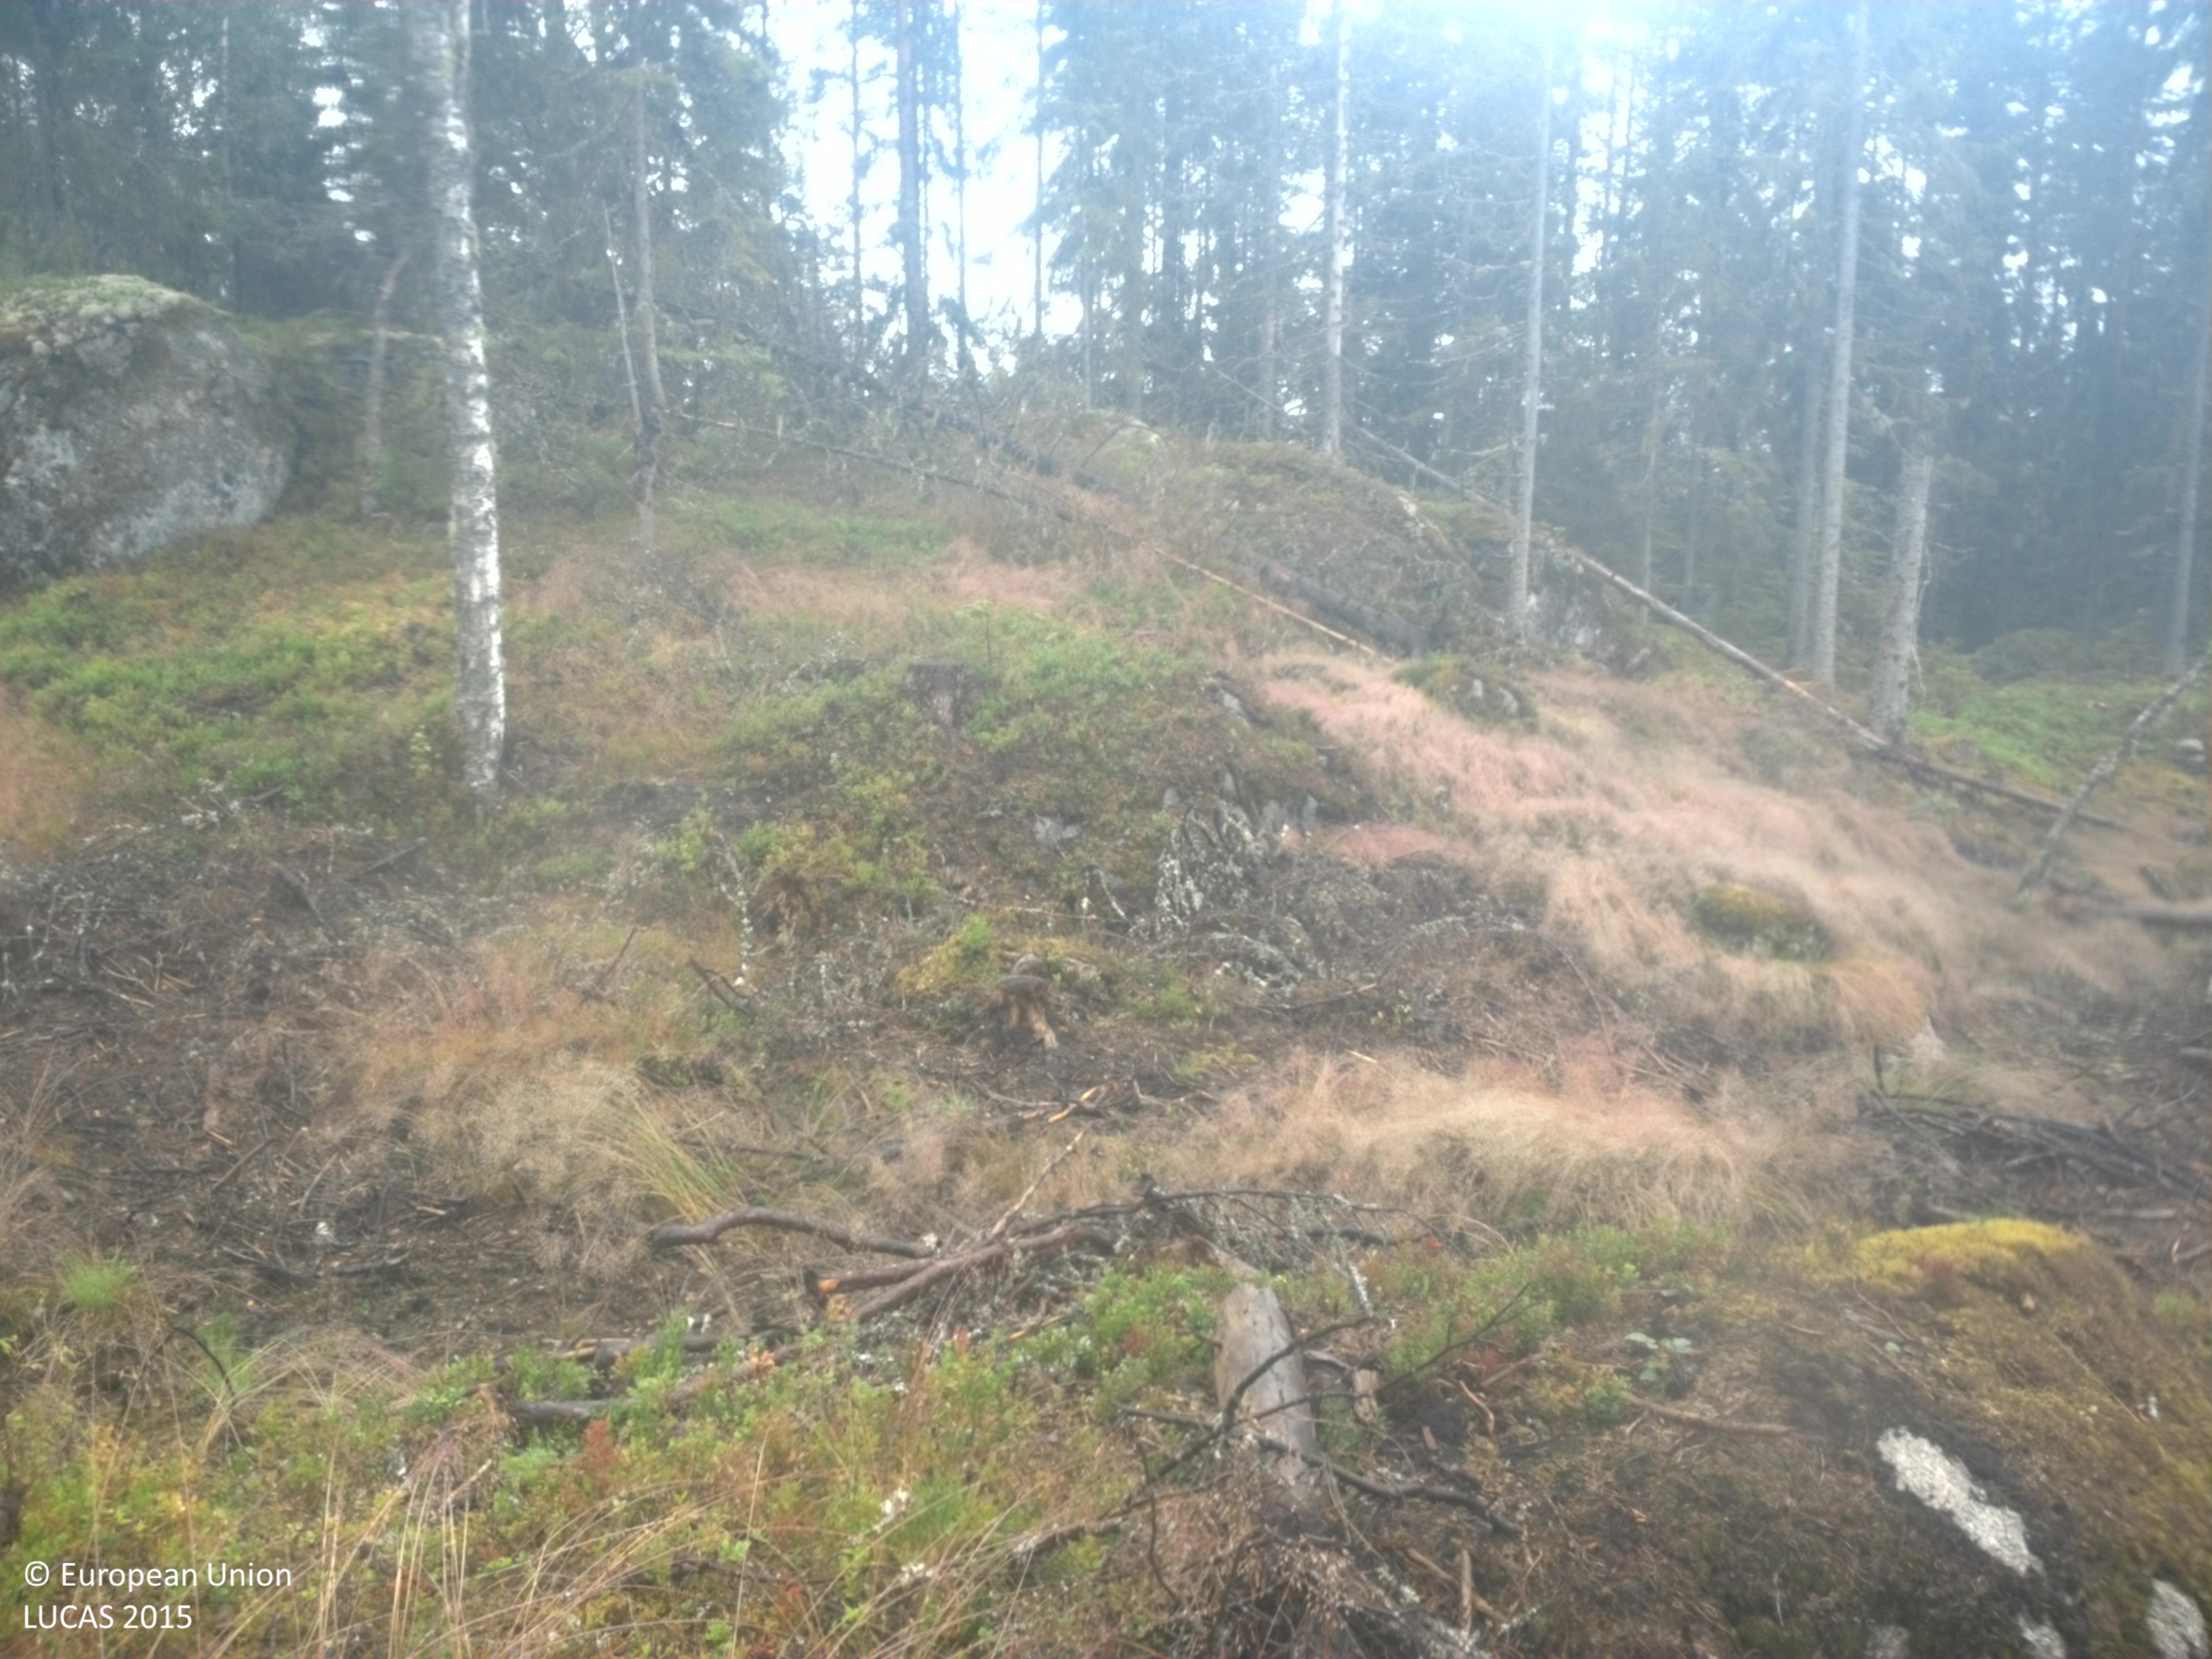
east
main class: Woodland
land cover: Broadleaved woodland
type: boreal forest
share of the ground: 10 - 25 %
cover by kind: herbaceous plants 50 %, shrubs 25 %, broadleaved forest trees 10 %, consolidated bare surface 10 %, lichens and mosses 5 %
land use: Forestry
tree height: > 5 m
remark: Clear cut
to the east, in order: Broadleaved woodland; Tracks; Broadleaved woodland; Other mixed woodland; Spruce dominated mixed woodland; Ditches and canals; Spruce dominated coniferous woodland; Ditches and canals; Spruce dominated coniferous woodland; Spruce dominated mixed woodland; Ditches and canals; Shruby margins; Paved roads, cycling and walking lanes; Grass margins; Ditches and canals; Pine dominated coniferous woodland
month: July
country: SE
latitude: 59.2366
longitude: 14.7066
